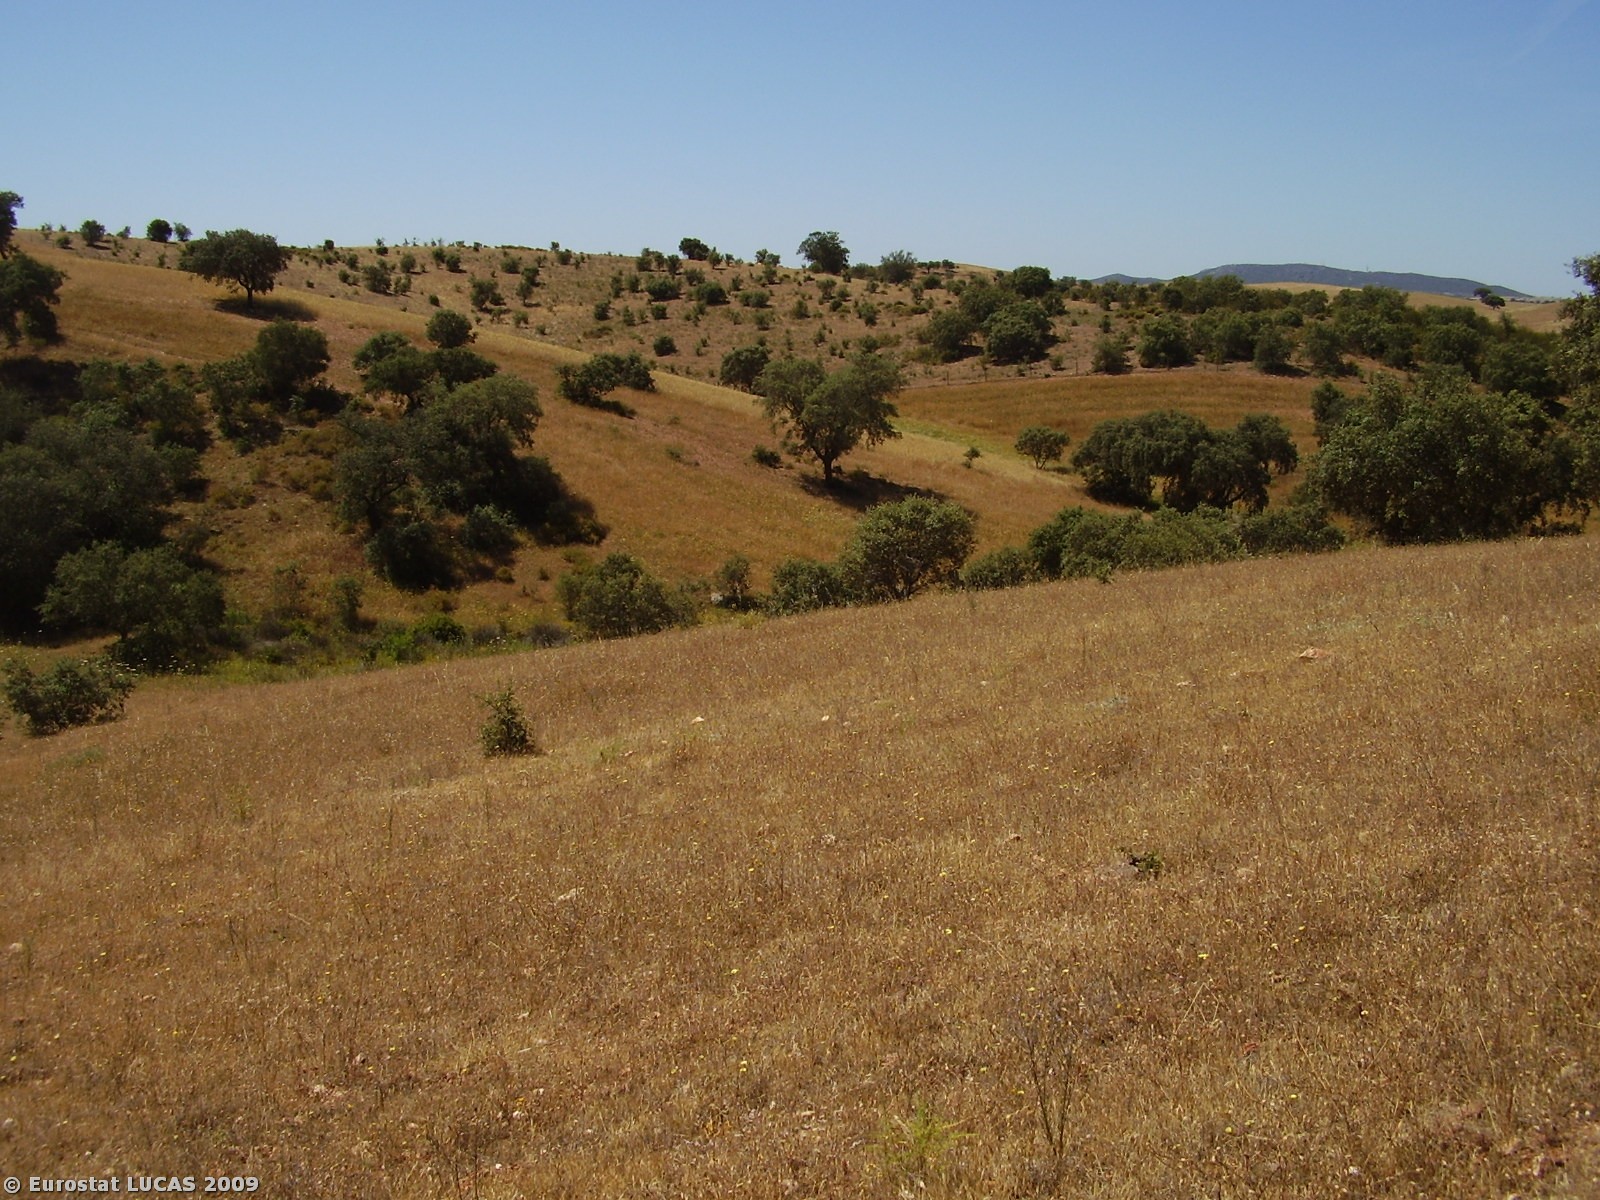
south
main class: Woodland
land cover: Broadleaved woodland
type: broadleaved evergreen forest
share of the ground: 10 - 25 %
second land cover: Bare land
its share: 25 - 50 %
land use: Forestry
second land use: Fallow land
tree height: > 5 m
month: May
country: PT
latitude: 37.7713
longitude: -7.7185
